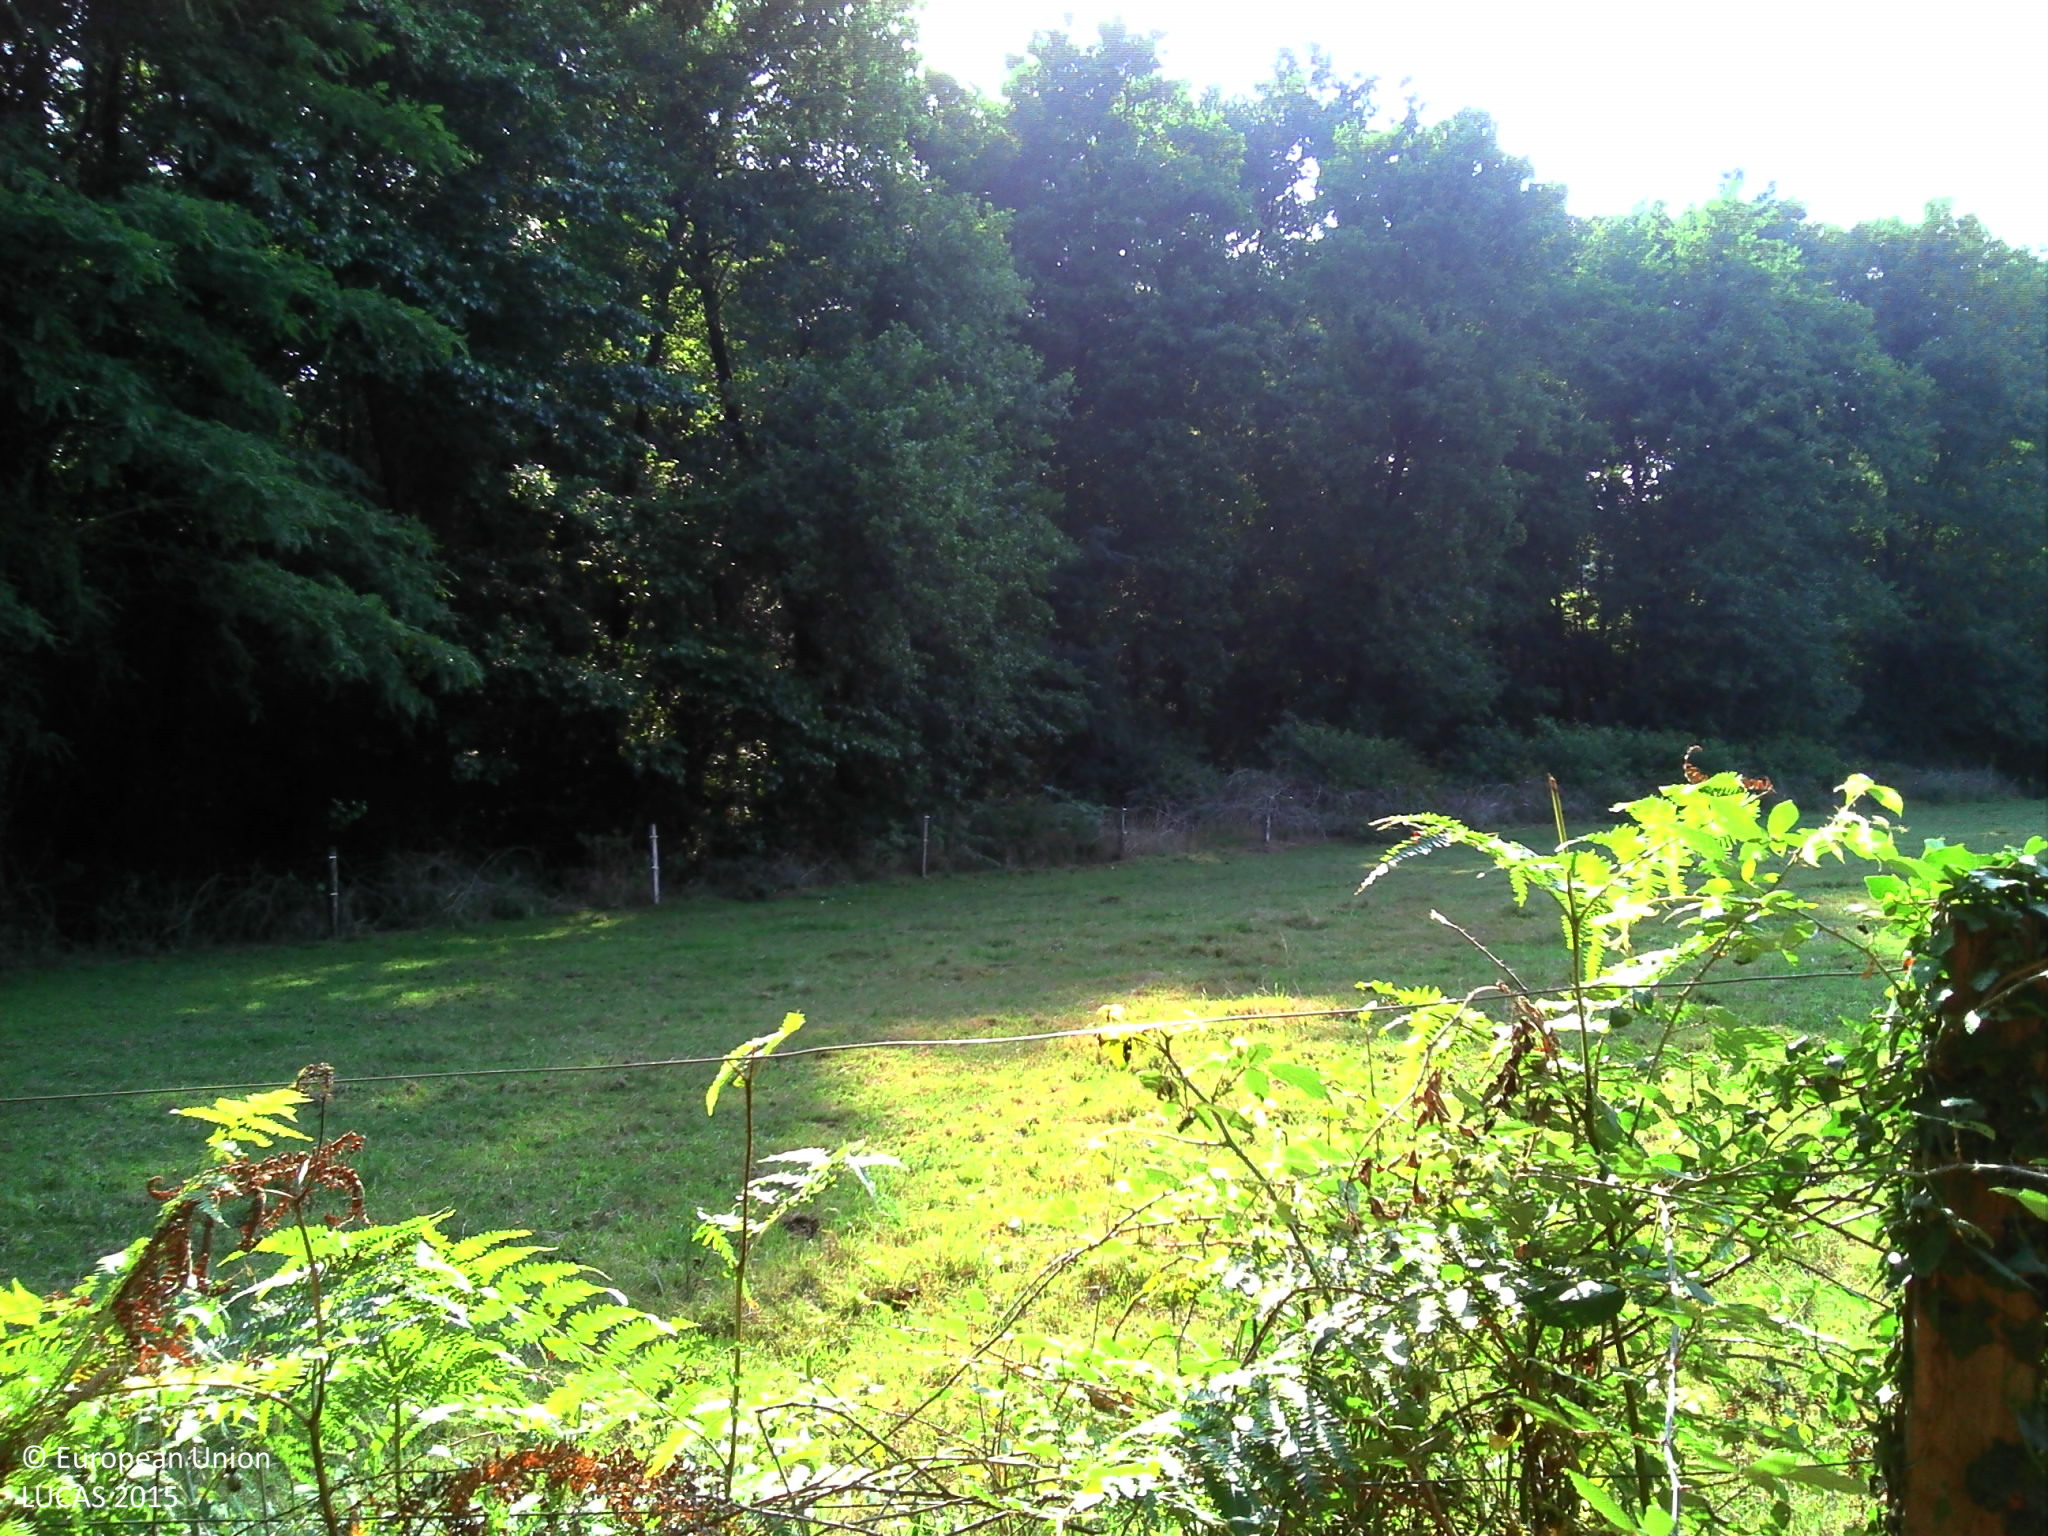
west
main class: Woodland
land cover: Broadleaved woodland
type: mesophytic deciduous forest
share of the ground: > 75 %
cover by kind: broadleaved forest trees 85 %, herbaceous plants 15 %
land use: Forestry
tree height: > 5 m
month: August
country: FR
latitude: 43.7483
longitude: -0.8053
